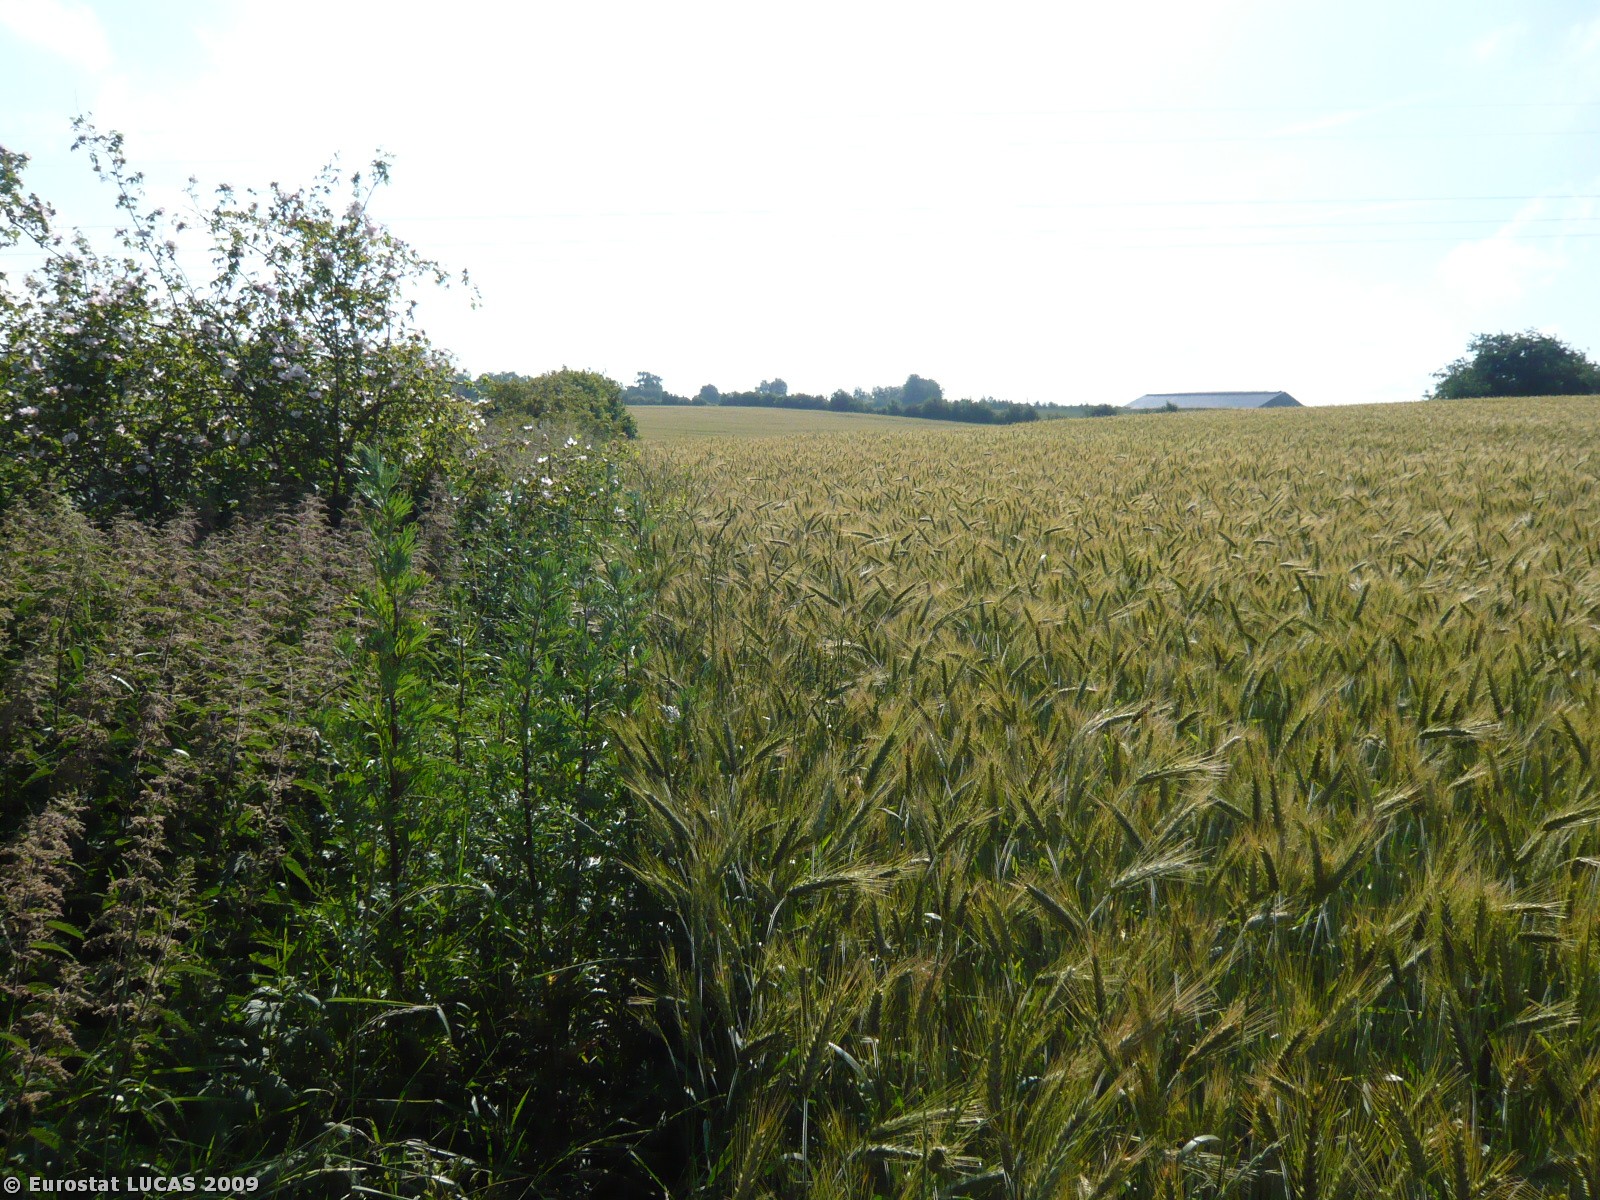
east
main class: Cropland
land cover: Triticale
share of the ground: > 75 %
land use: Agriculture (excluding fallow land and kitchen gardens)
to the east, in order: Triticale; Electric lines; Triticale
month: June
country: DK
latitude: 55.2170
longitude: 10.1728
